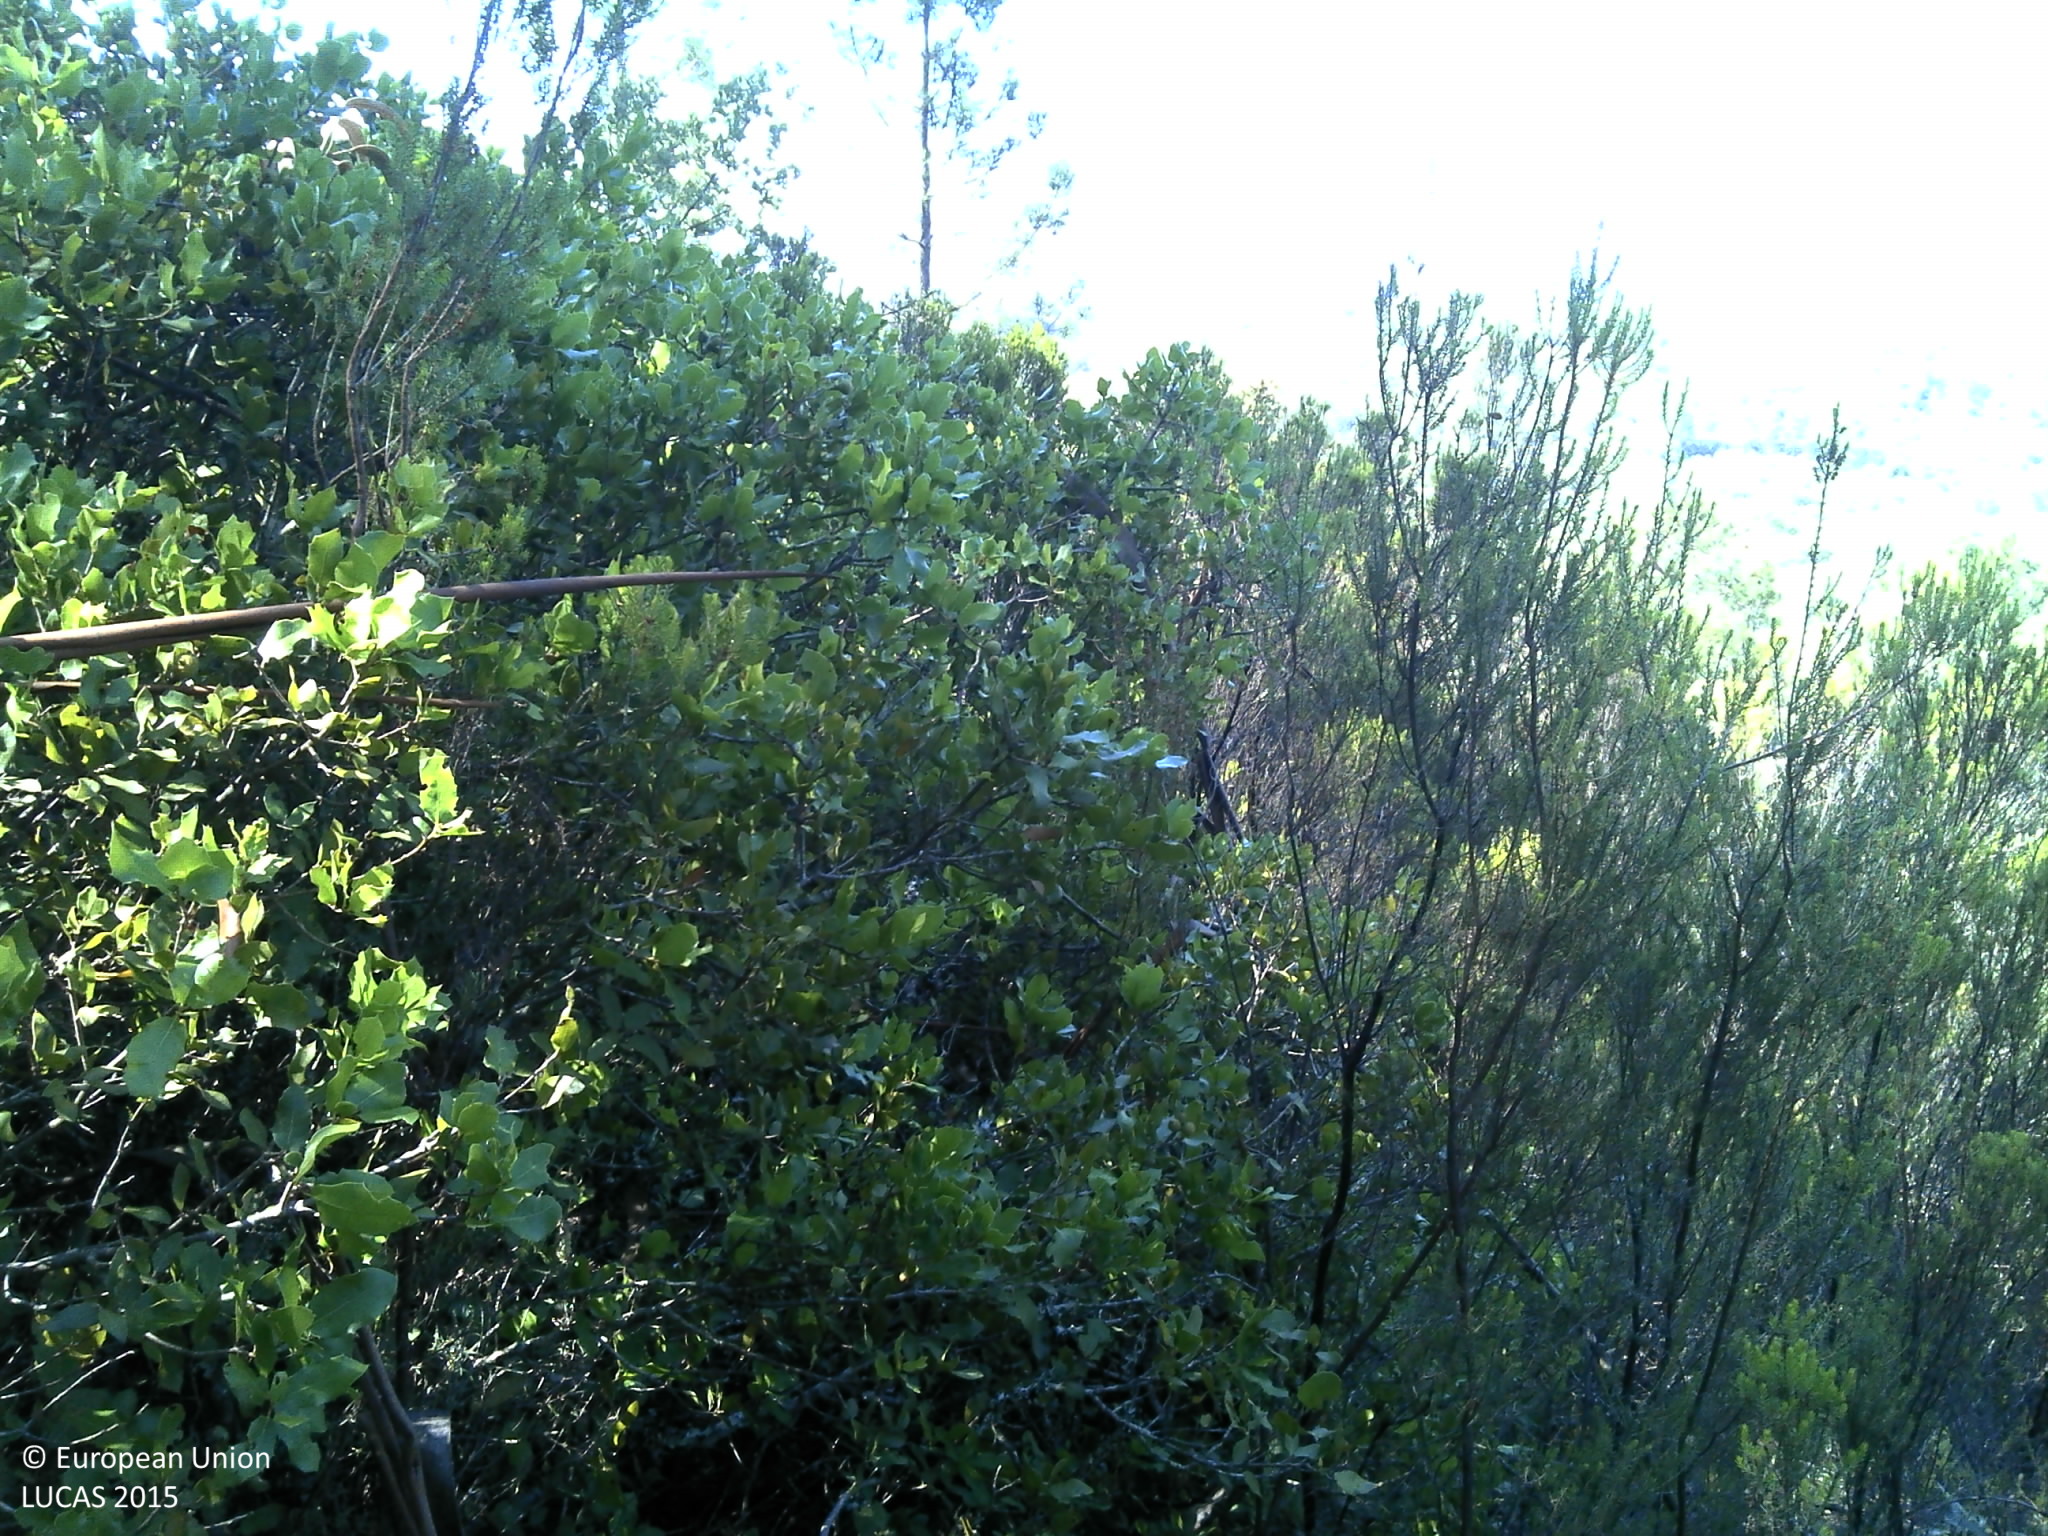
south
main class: Woodland
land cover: Broadleaved woodland
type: exotic forest
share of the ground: 50 - 75 %
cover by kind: broadleaved forest trees 60 %, shrubs 20 %, consolidated bare surface 10 %, unconsolidated bare surface 10 %
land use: Forestry
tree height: > 5 m
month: July
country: PT
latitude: 39.7827
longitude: -8.4192
